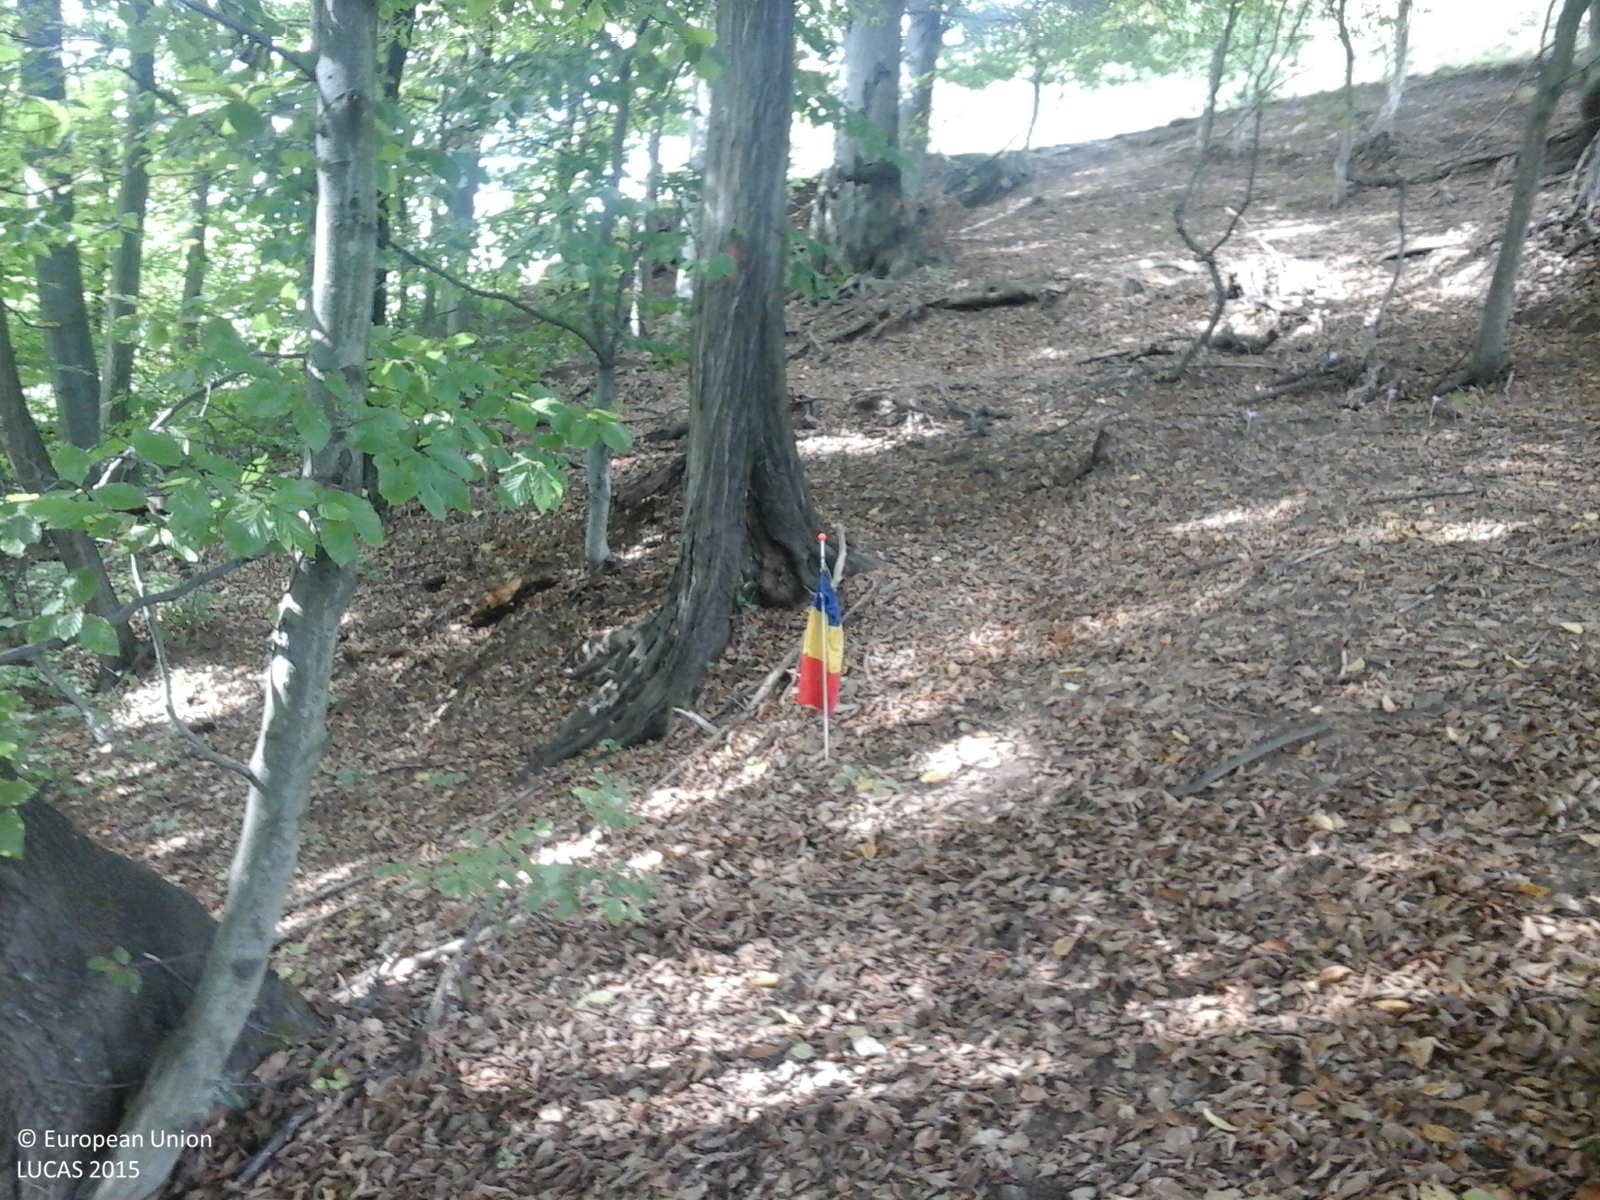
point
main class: Woodland
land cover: Broadleaved woodland
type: beech forest
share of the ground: > 75 %
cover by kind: broadleaved forest trees 100 %
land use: Forestry
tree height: > 5 m
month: October
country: RO
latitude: 46.0990
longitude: 23.1631
